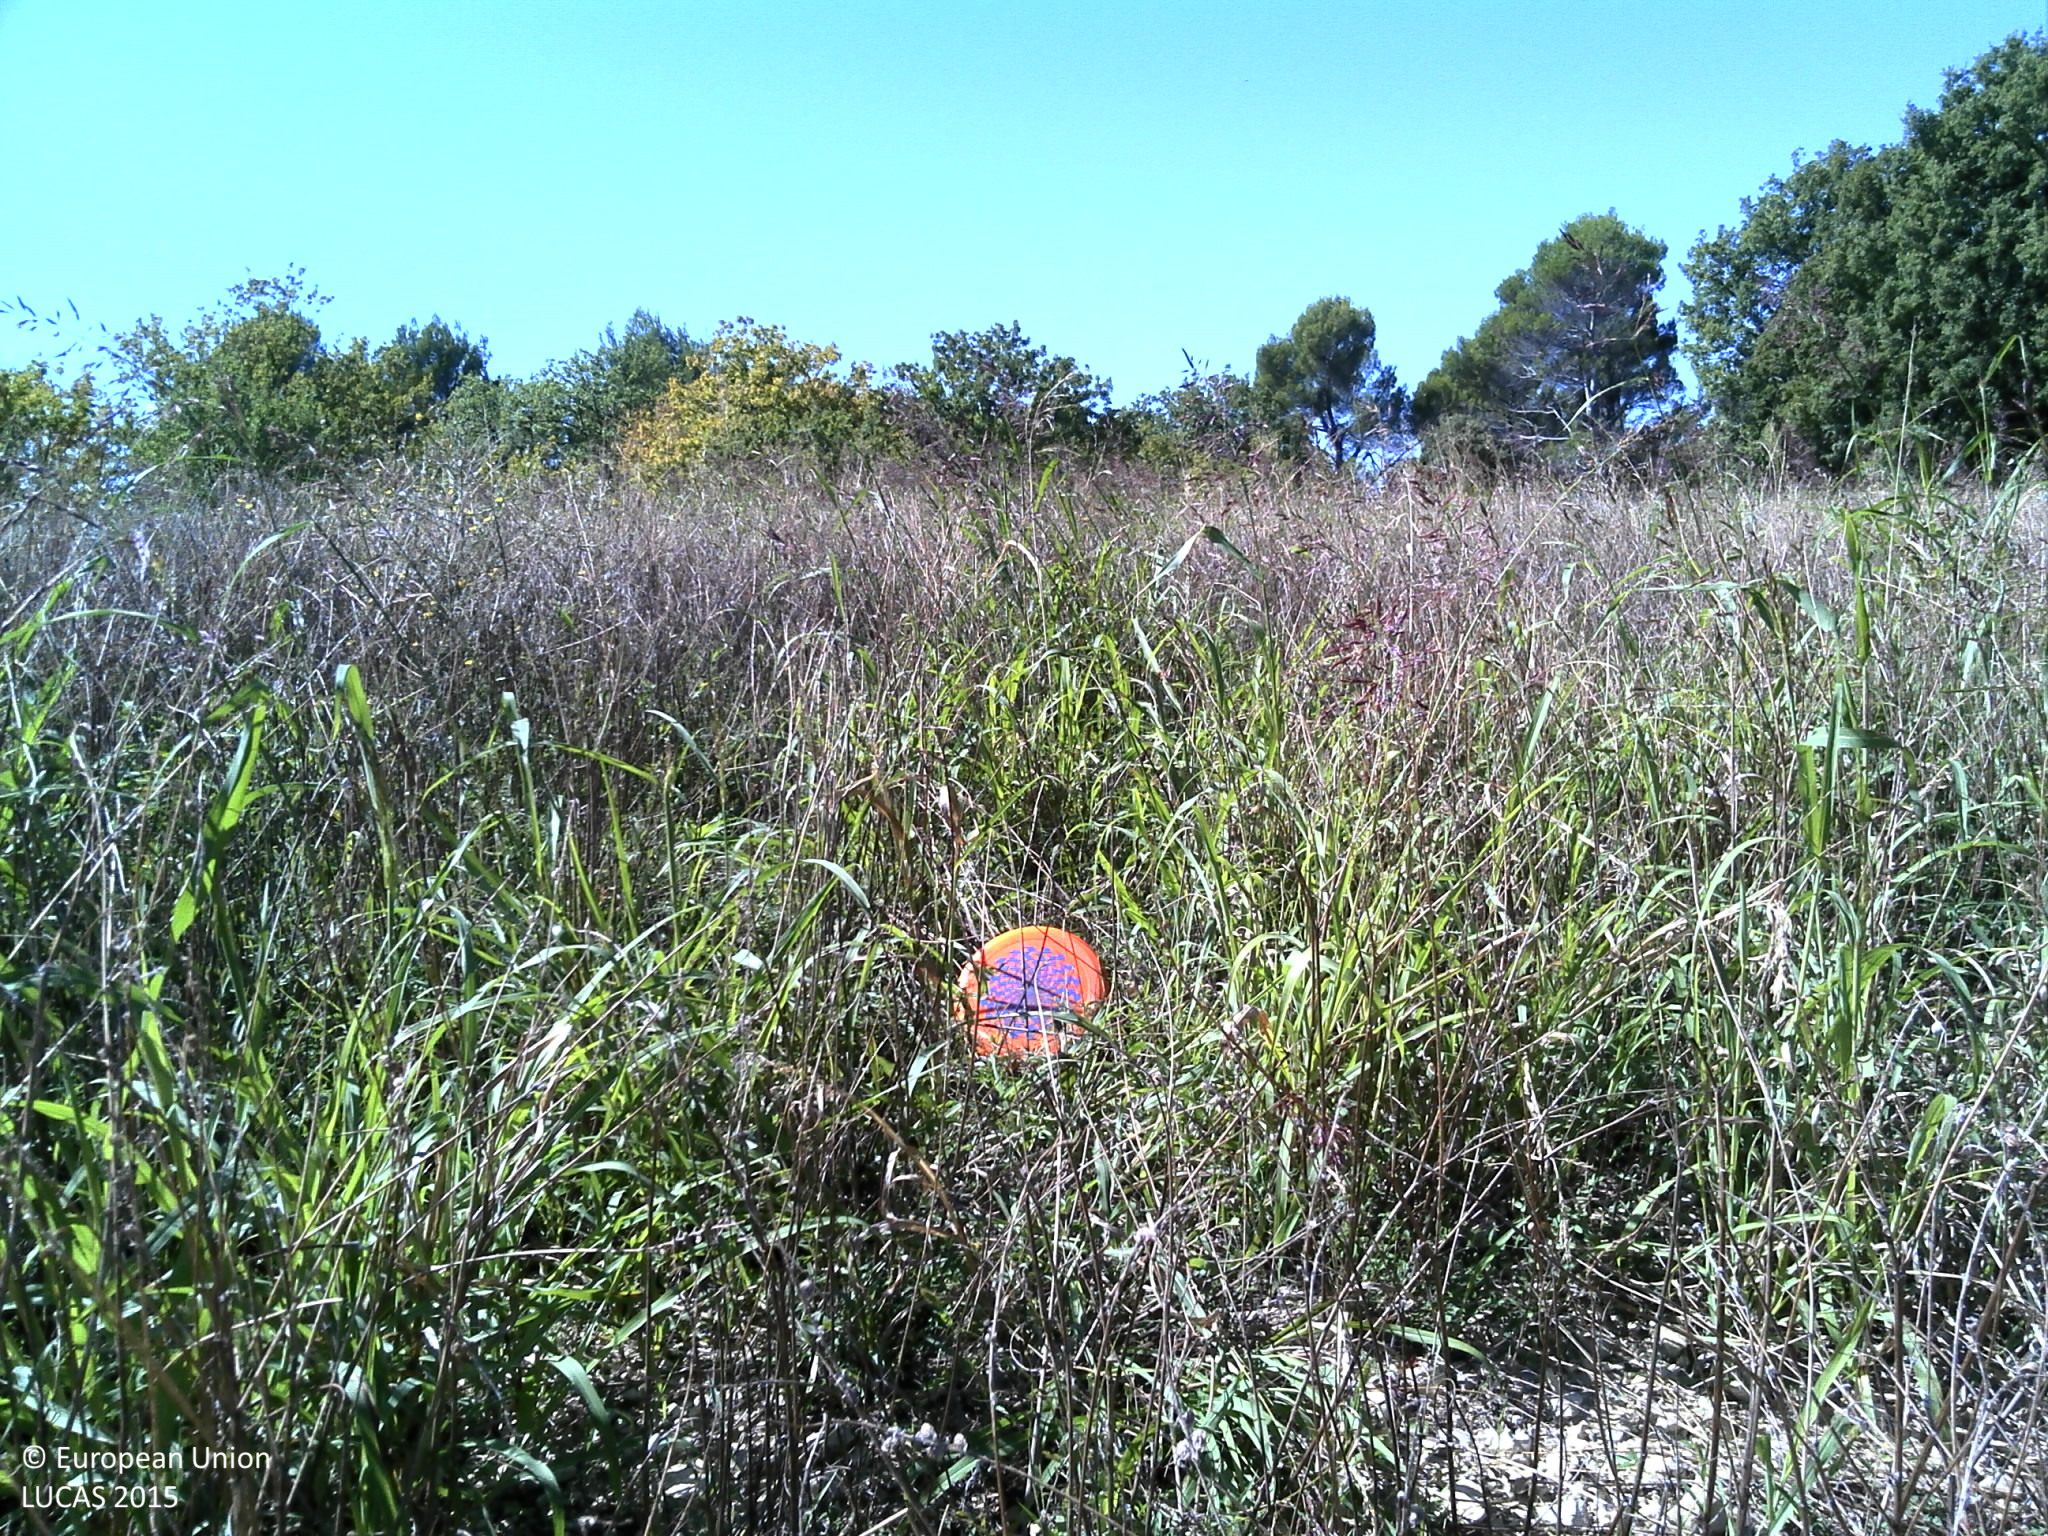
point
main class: Cropland
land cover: Other leguminous and mixtures for fodder
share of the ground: > 75 %
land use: Agriculture (excluding fallow land and kitchen gardens)
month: September
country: FR
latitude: 43.7641
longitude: 5.4750
